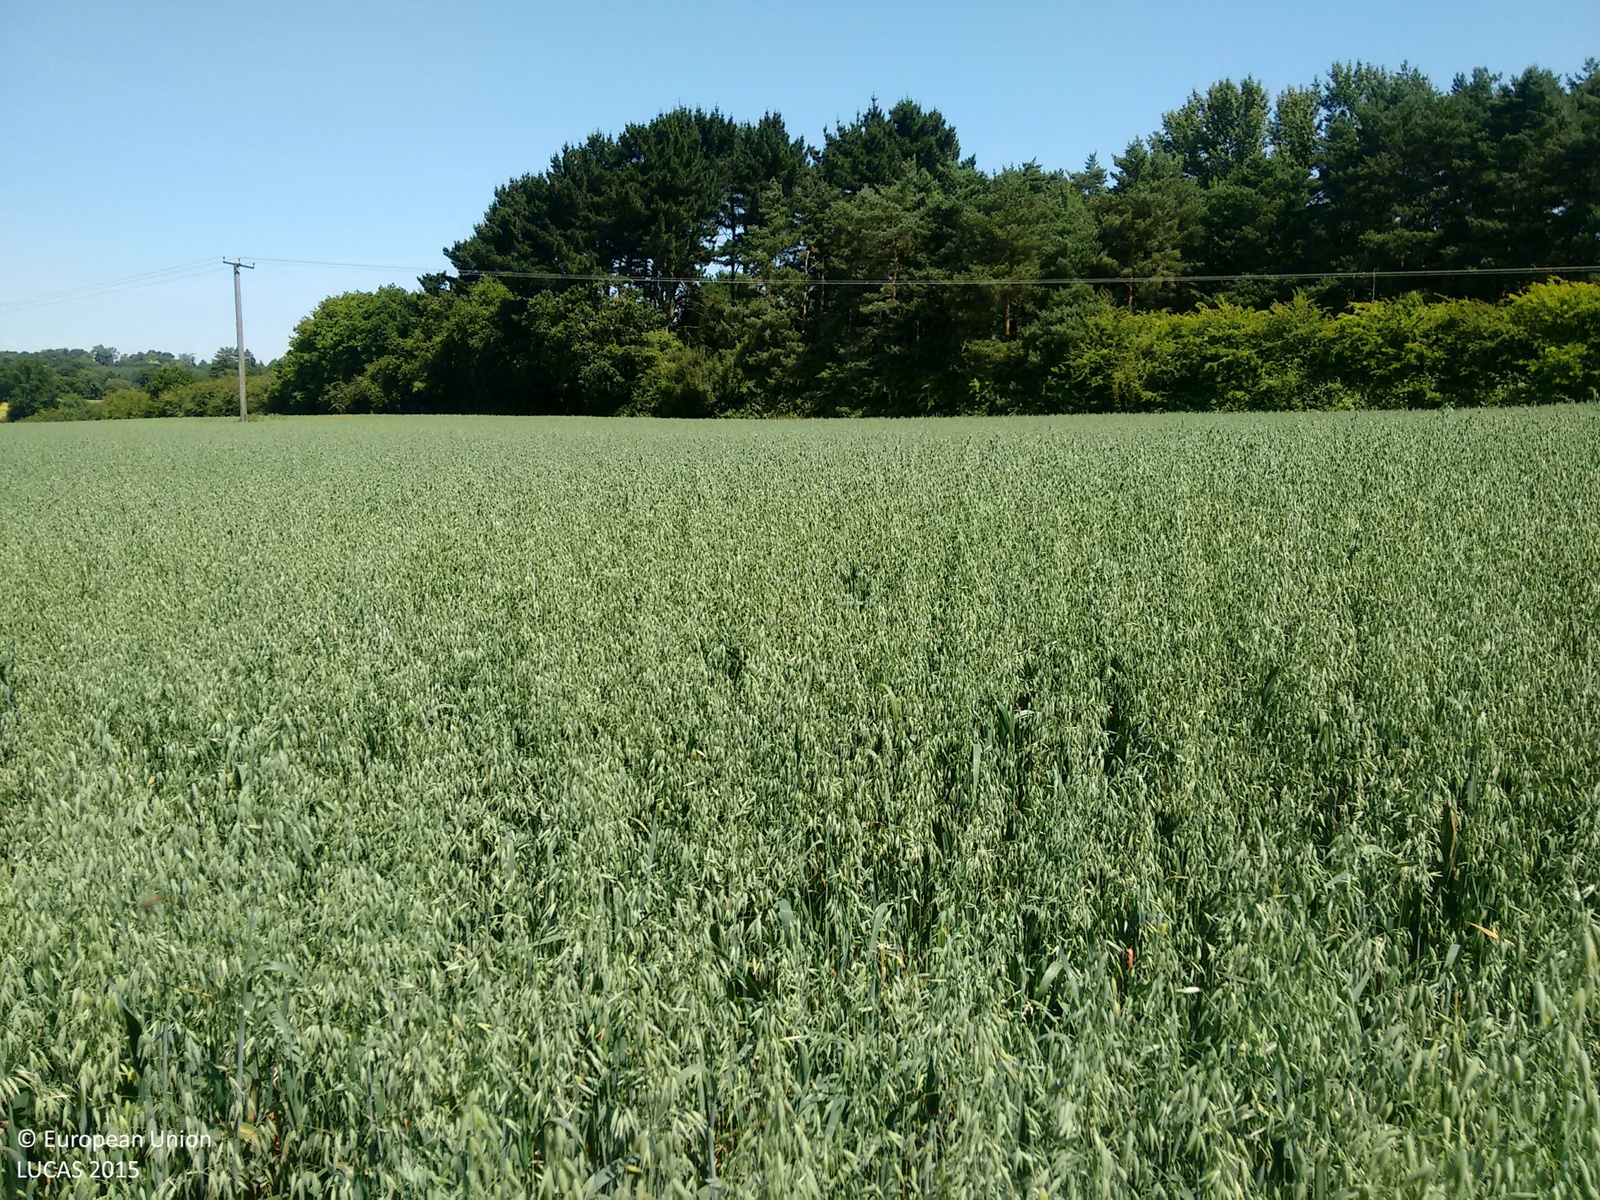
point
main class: Cropland
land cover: Oats
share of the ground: > 75 %
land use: Agriculture (excluding fallow land and kitchen gardens)
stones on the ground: 10 - 25 %
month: July
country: GB
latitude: 51.0713
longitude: -0.3551
